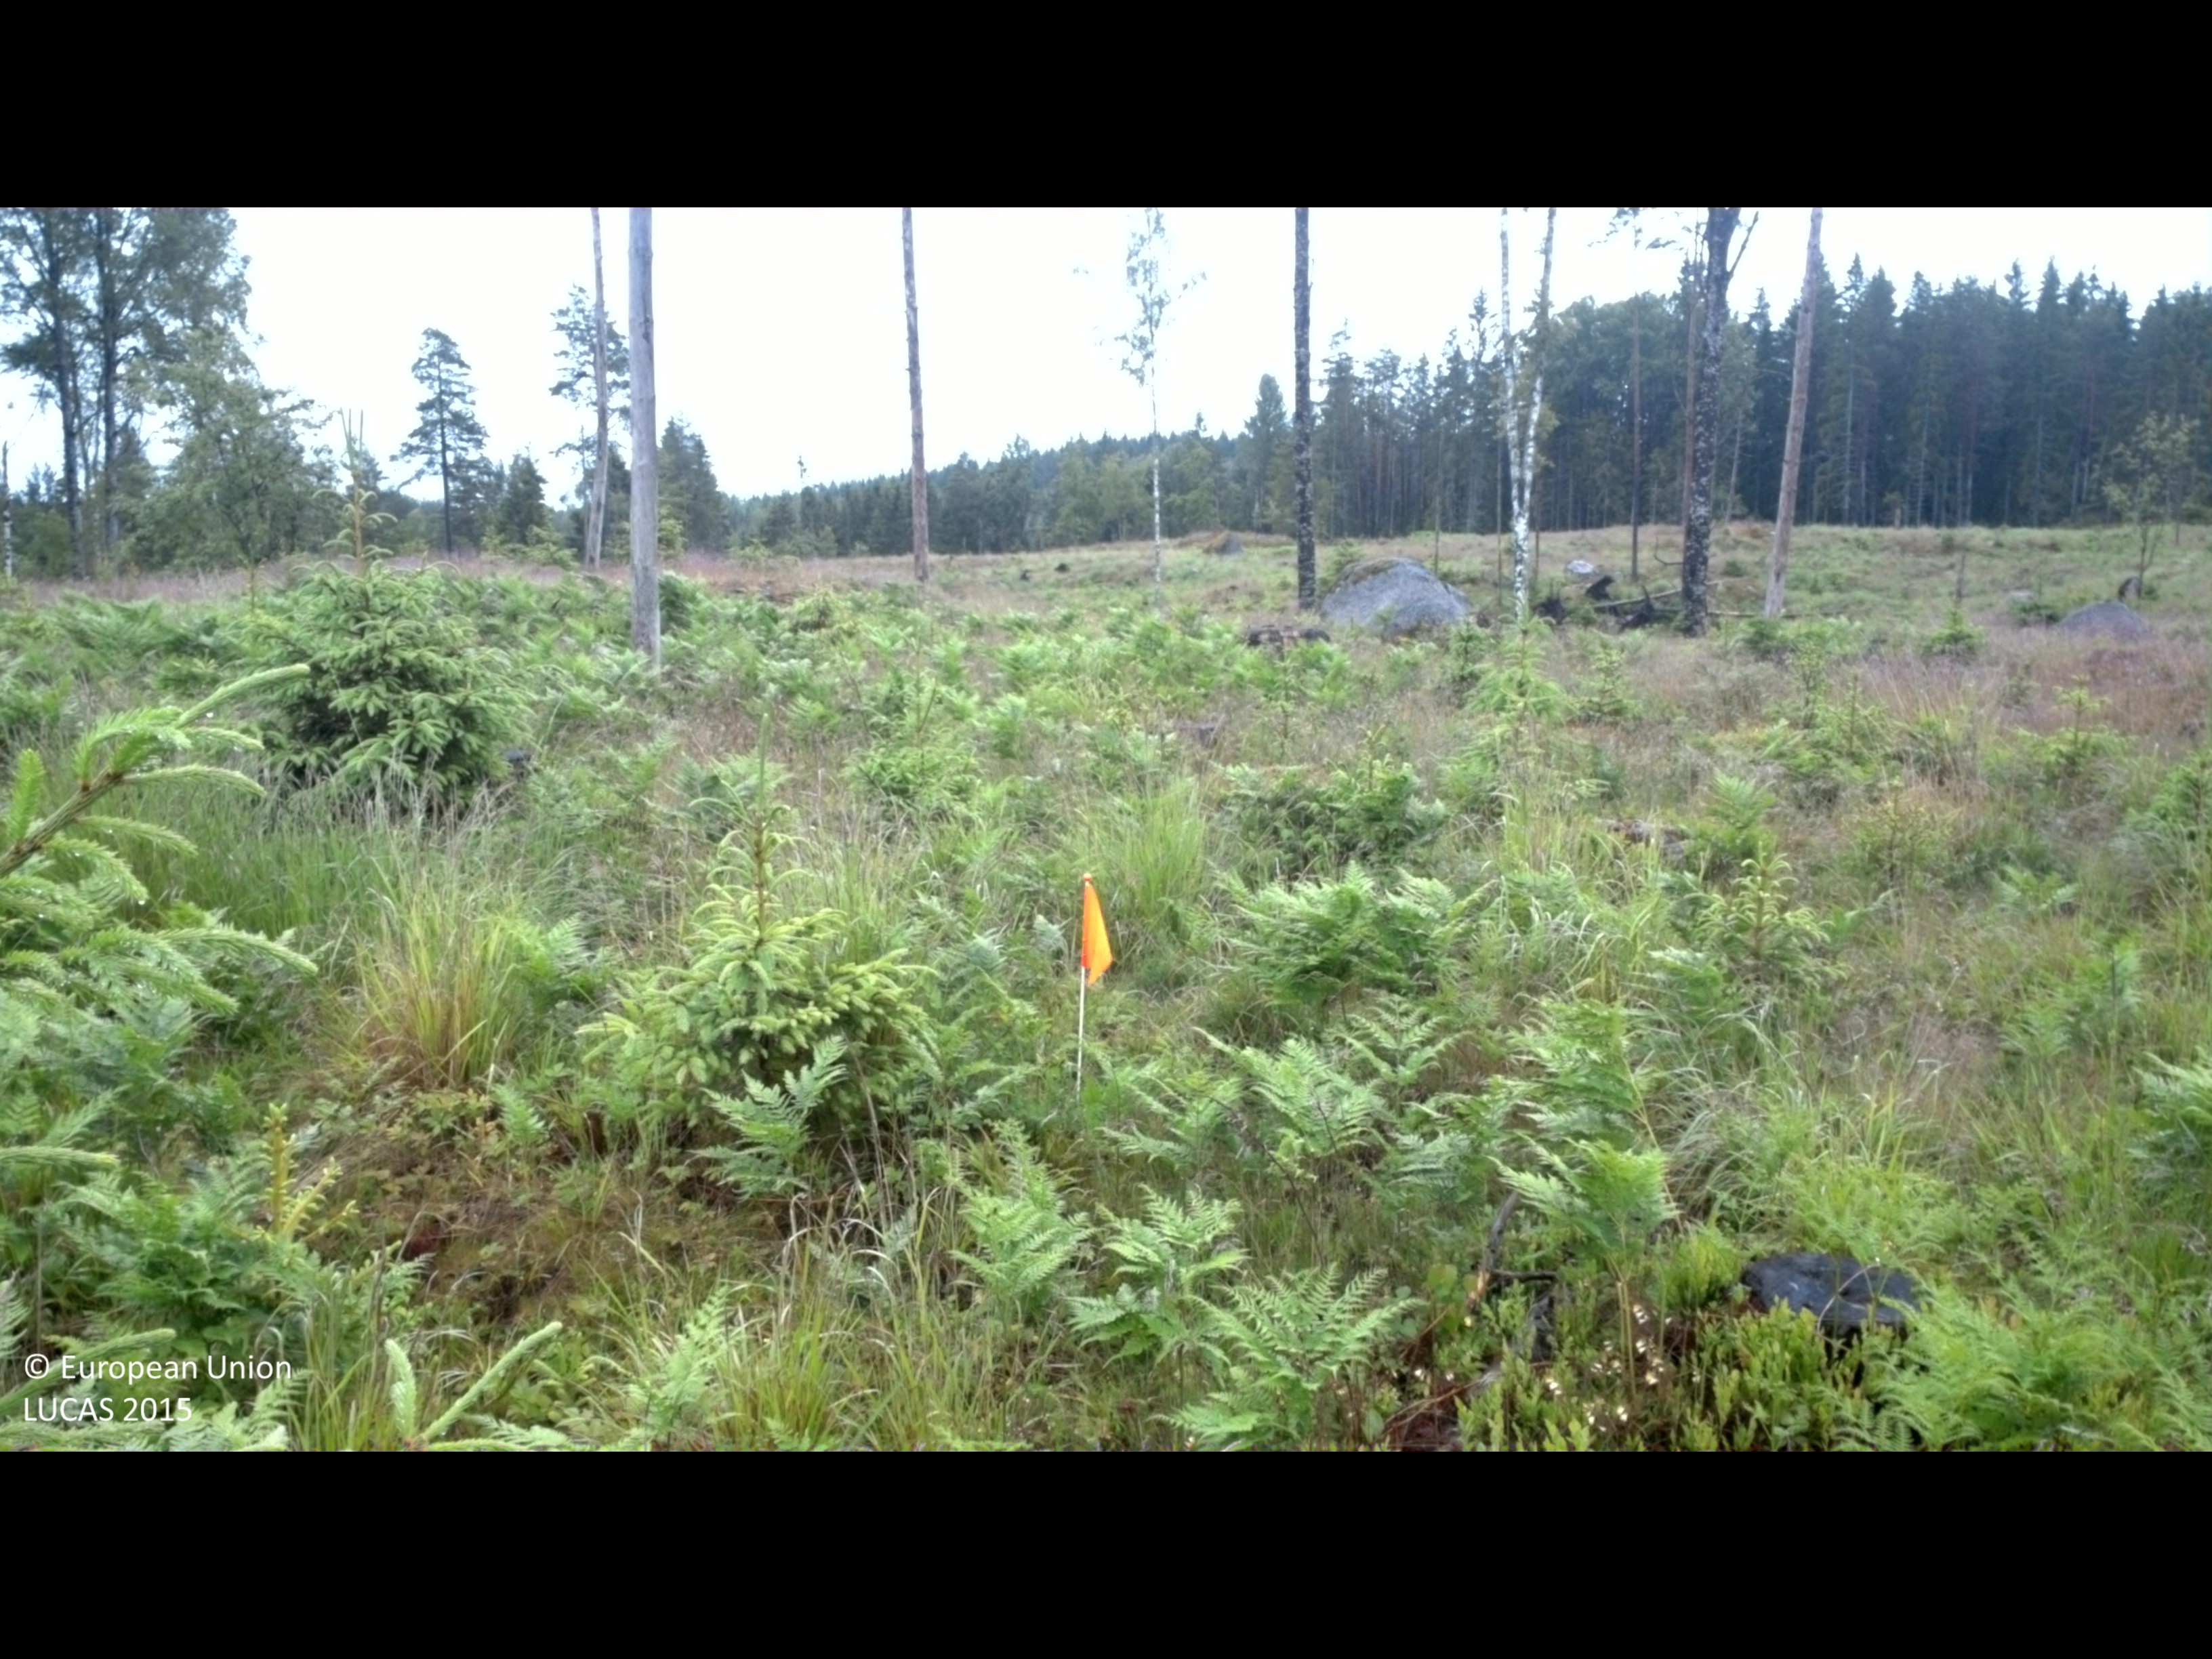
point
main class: Woodland
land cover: Spruce dominated coniferous woodland
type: boreal forest
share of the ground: 10 - 25 %
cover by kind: herbaceous plants 70 %, coniferous forest trees 15 %, shrubs 15 %
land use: Forestry
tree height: < 5 m
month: June
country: SE
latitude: 58.0592
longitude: 16.1824
